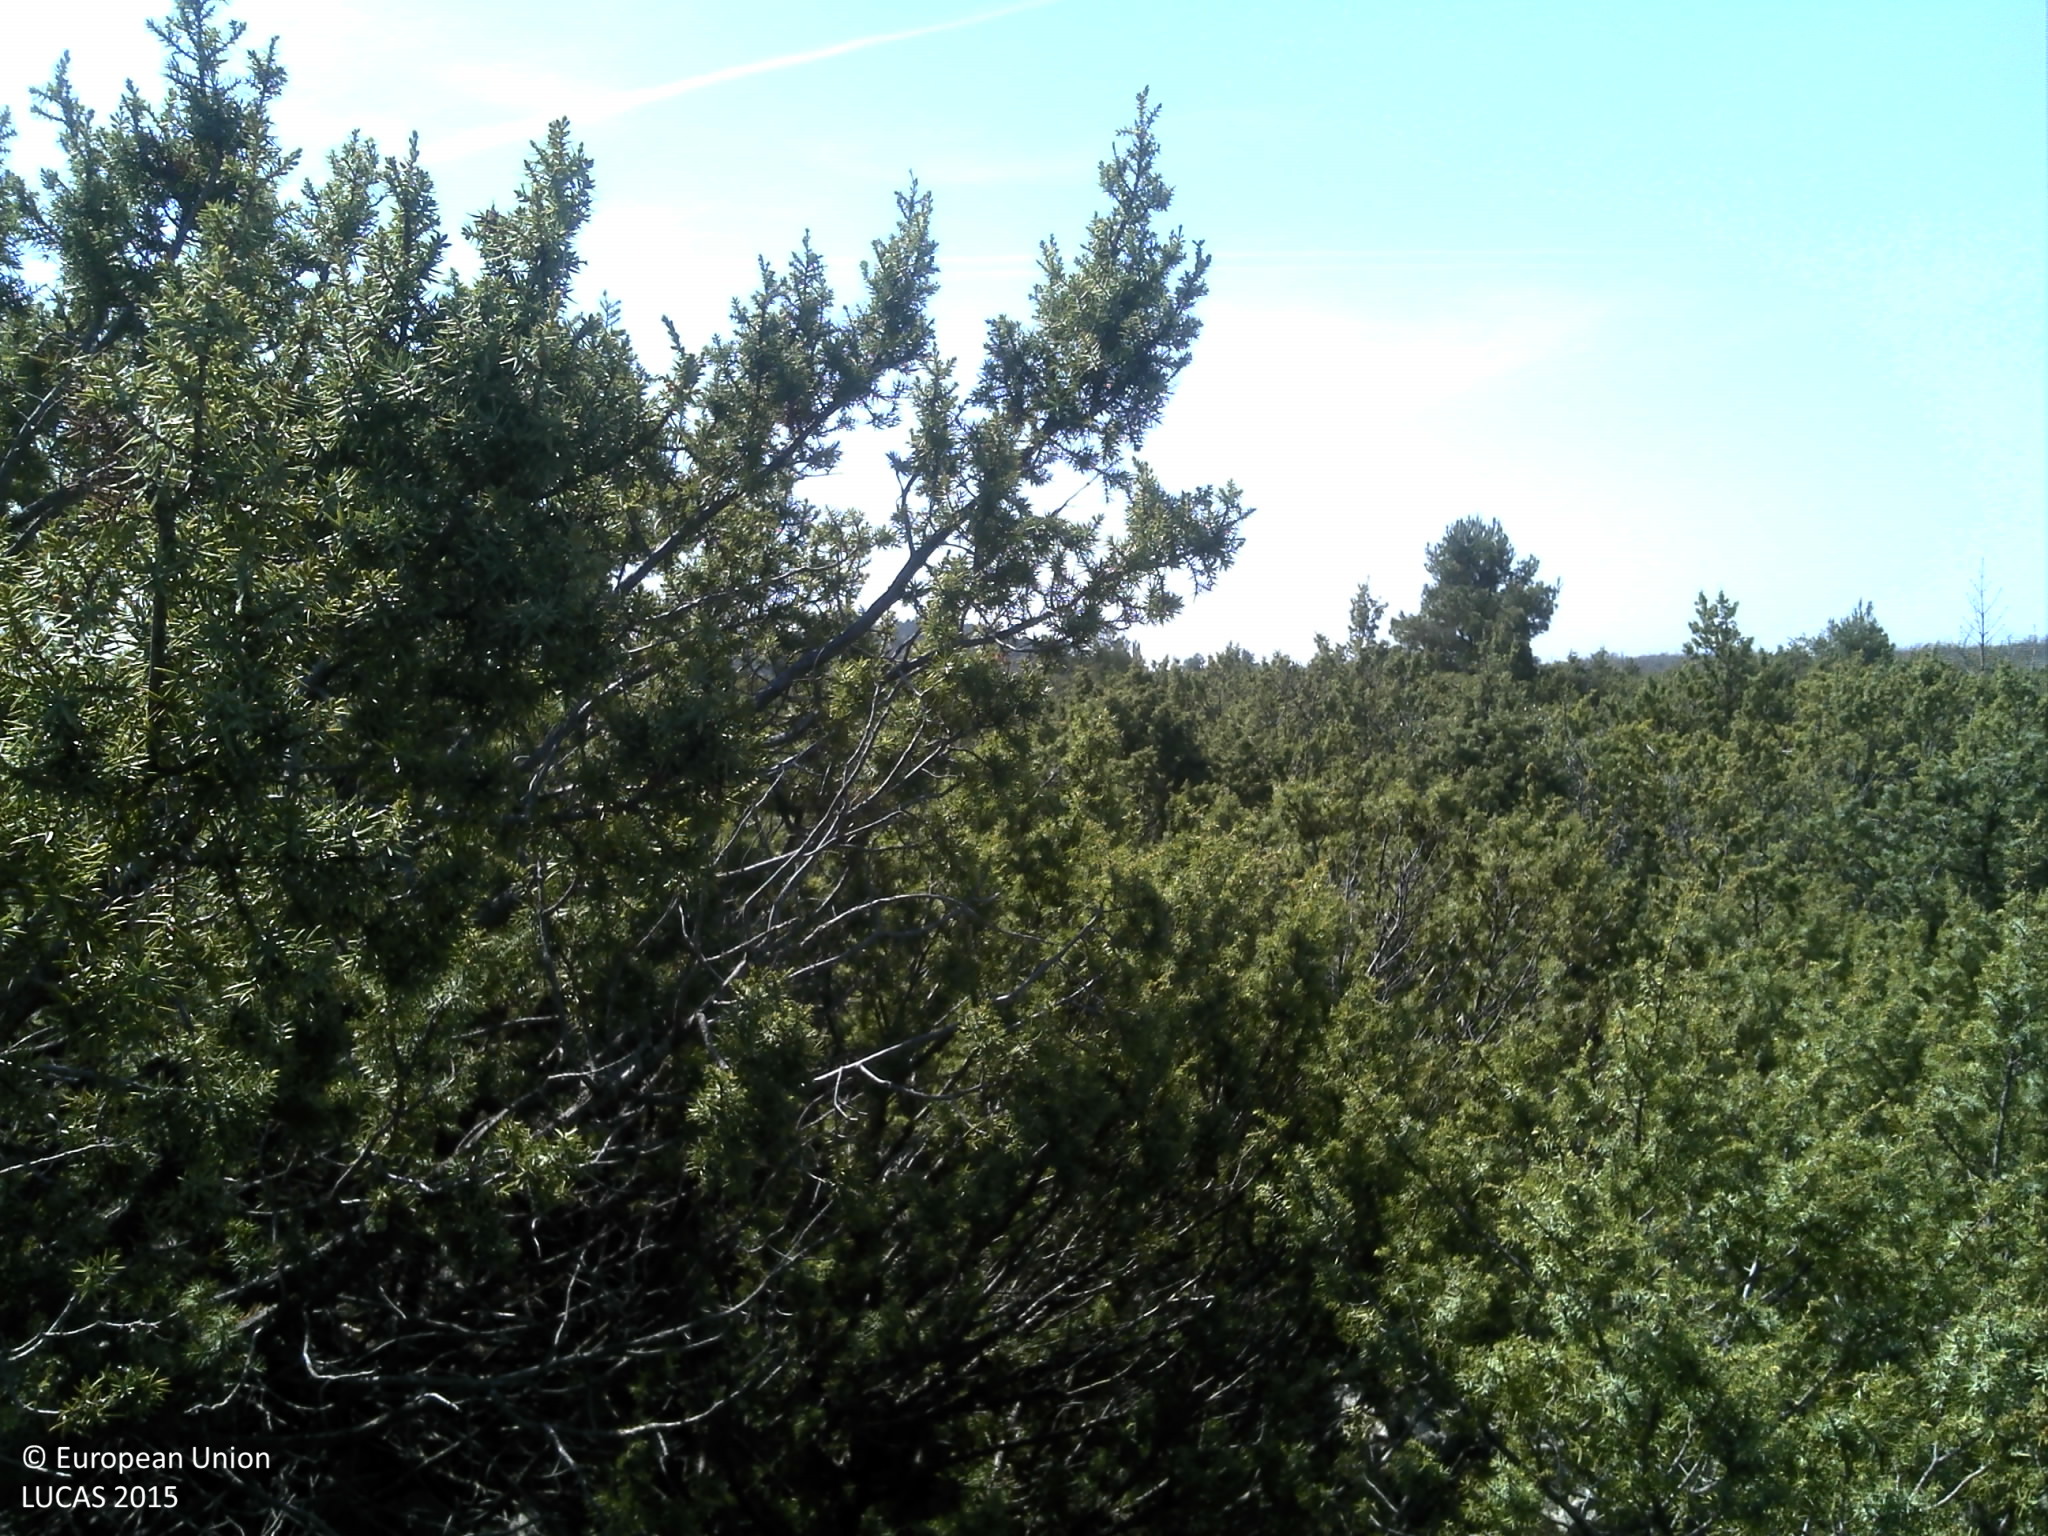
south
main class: Shrubland
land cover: Shrubland with sparse tree cover
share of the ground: > 75 %
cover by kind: shrubs 70 %, unconsolidated bare surface 10 %, broadleaved forest trees 5 %, consolidated bare surface 5 %
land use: Semi-natural and natural areas not in use
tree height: < 5 m
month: April
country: HR
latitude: 43.9513
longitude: 15.8358
